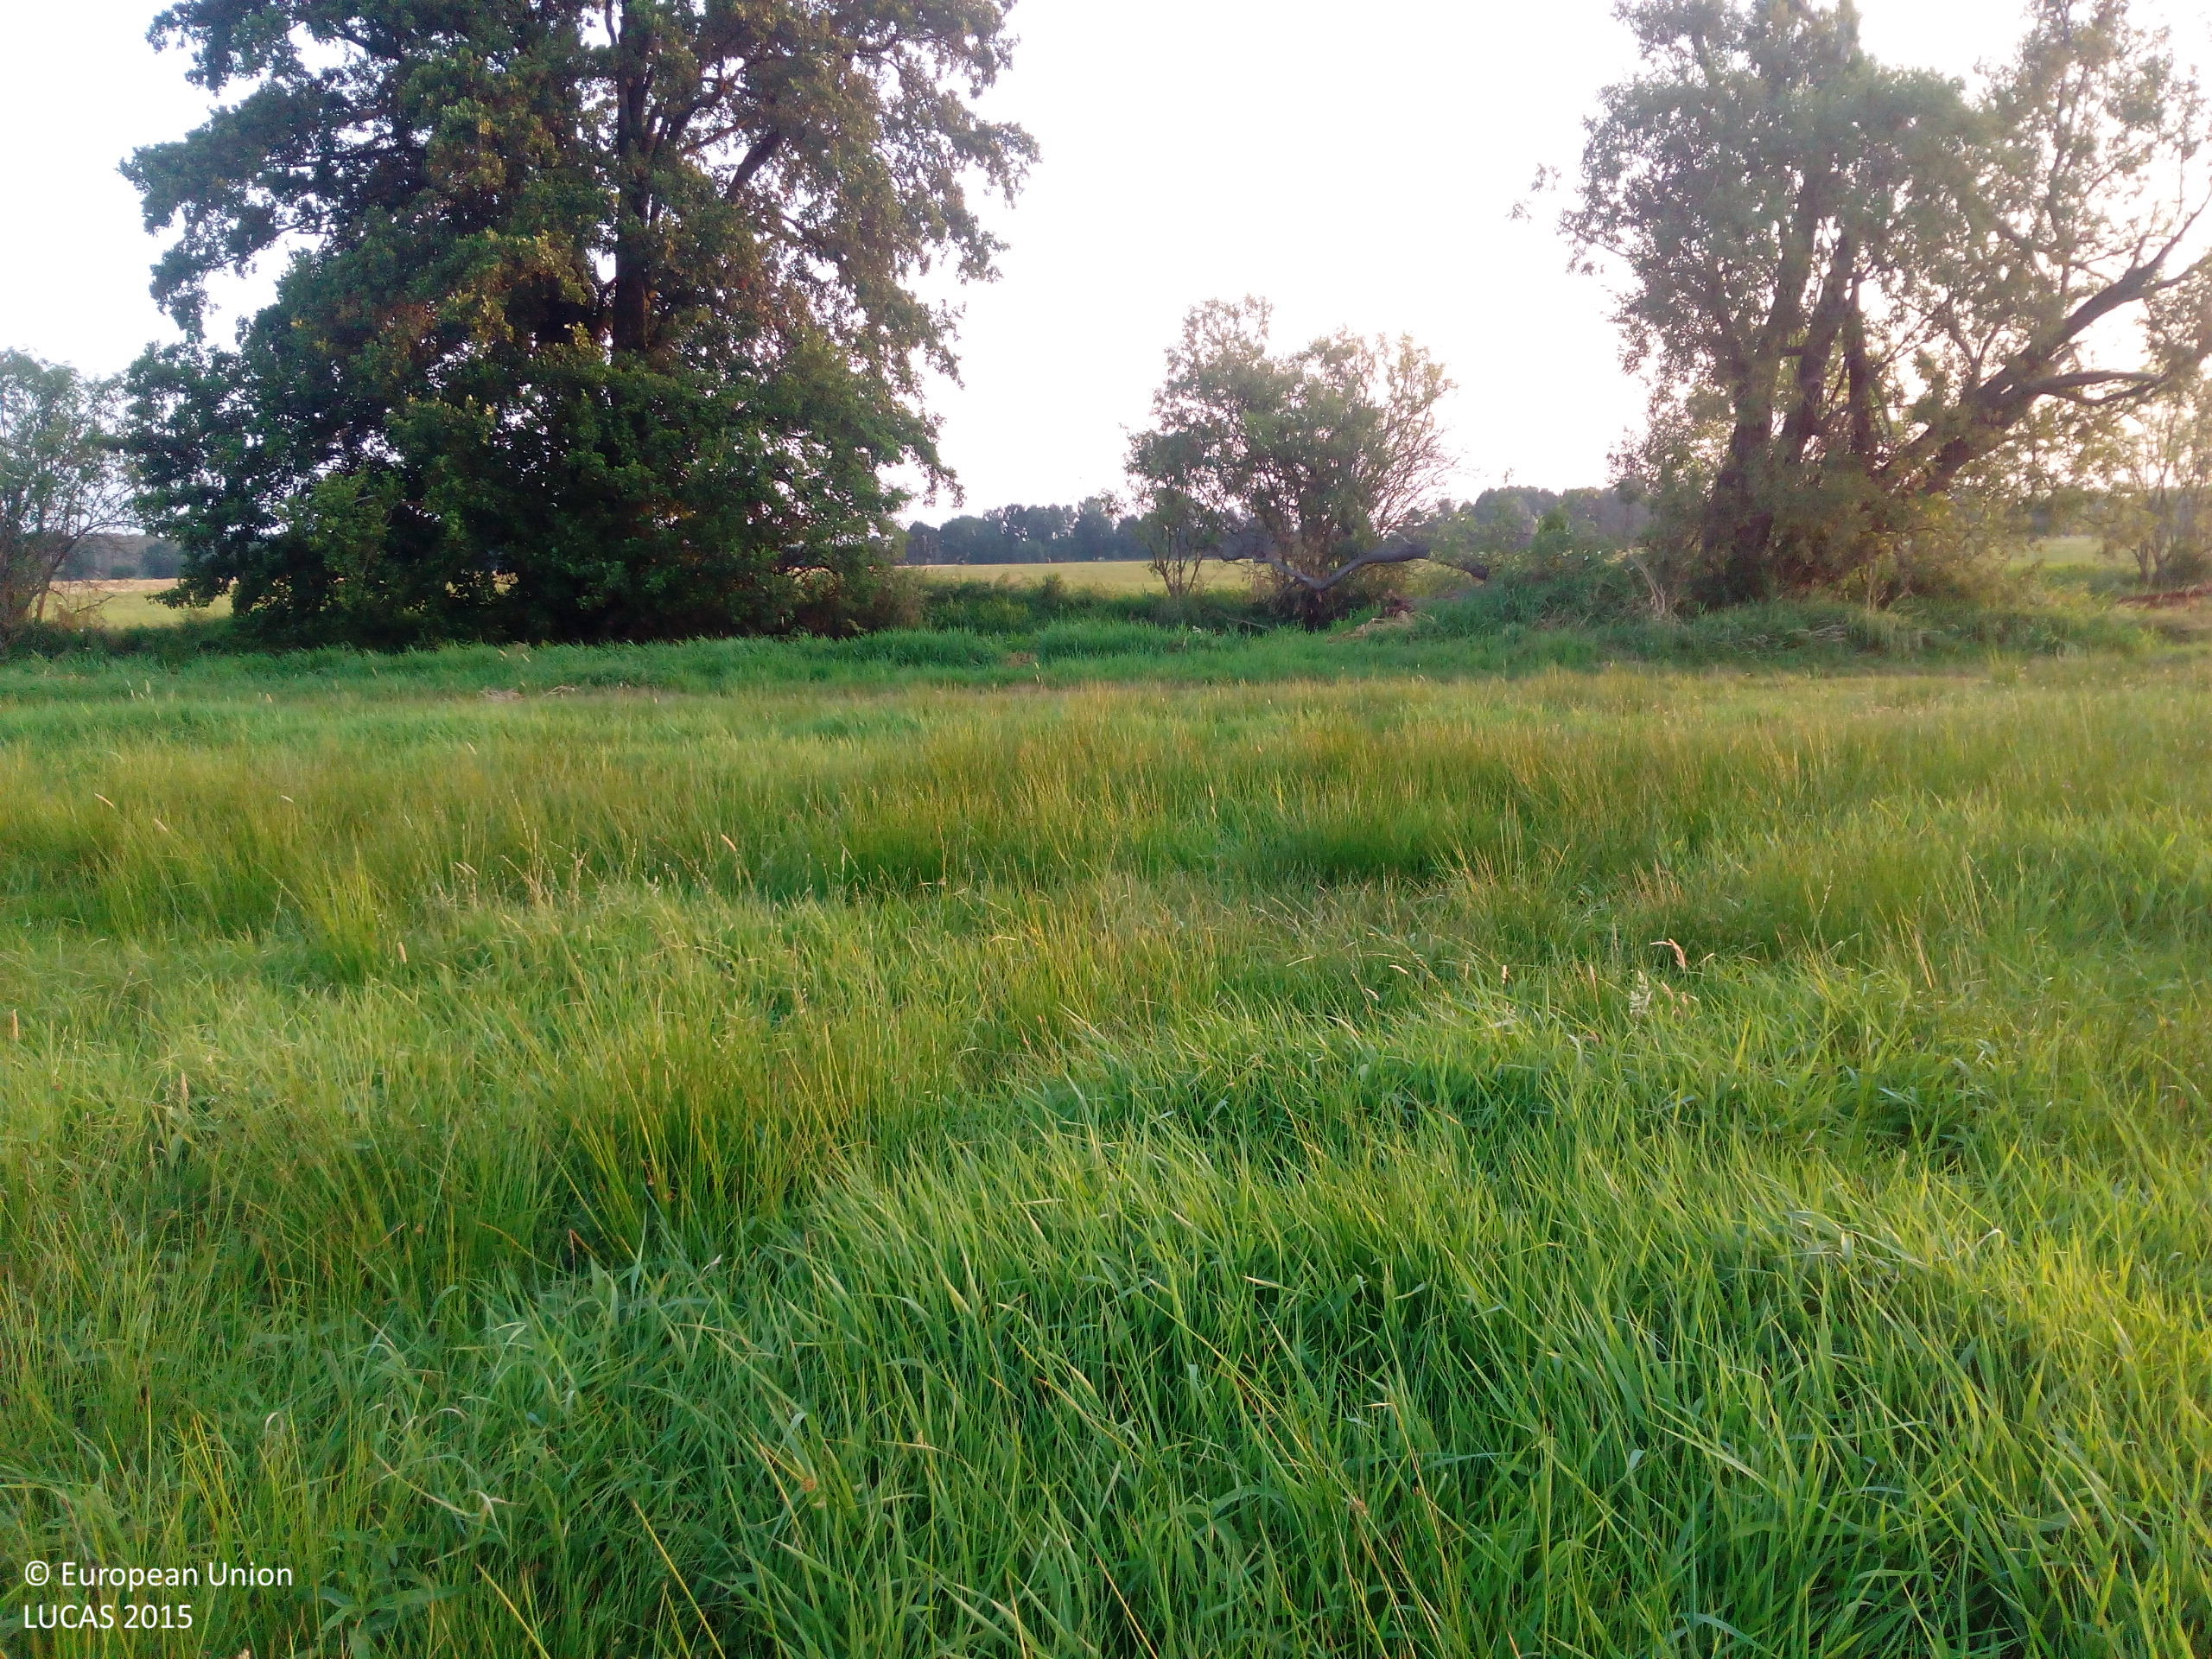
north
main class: Grassland
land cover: Grassland without tree/shrub cover
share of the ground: > 75 %
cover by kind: herbaceous plants 100 %
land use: Agriculture (excluding fallow land and kitchen gardens)
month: August
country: DE
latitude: 51.8470
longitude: 14.3709
